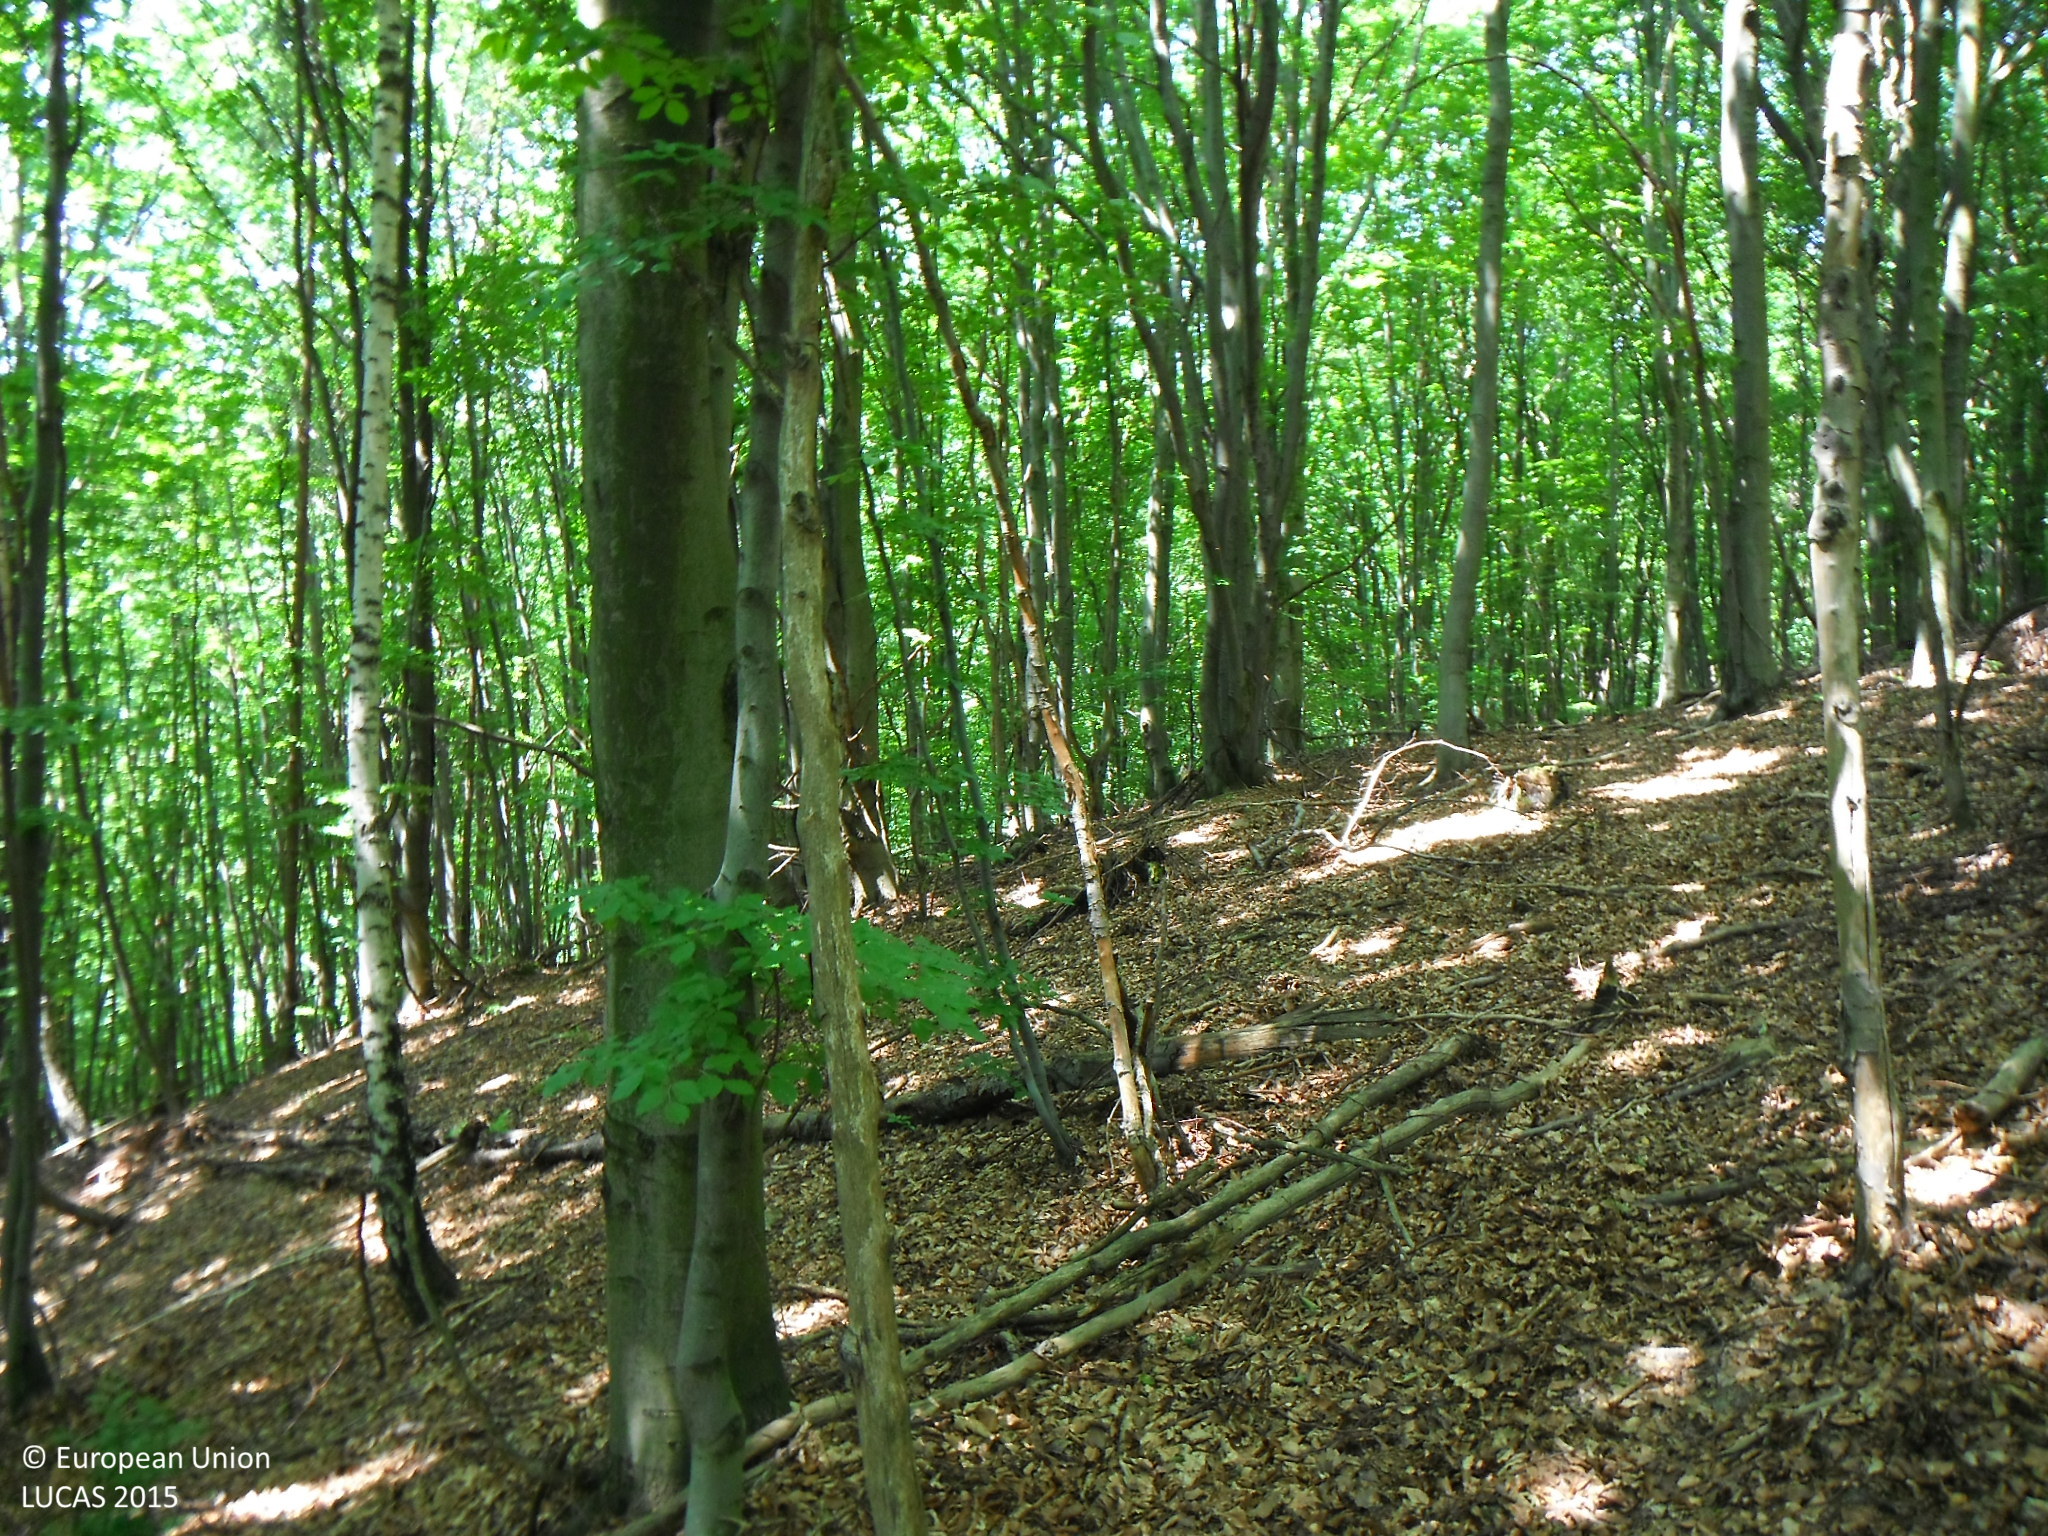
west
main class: Woodland
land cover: Broadleaved woodland
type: beech forest
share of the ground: > 75 %
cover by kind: broadleaved forest trees 100 %
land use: Forestry
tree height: > 5 m
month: July
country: SK
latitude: 49.3775
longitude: 21.1878
